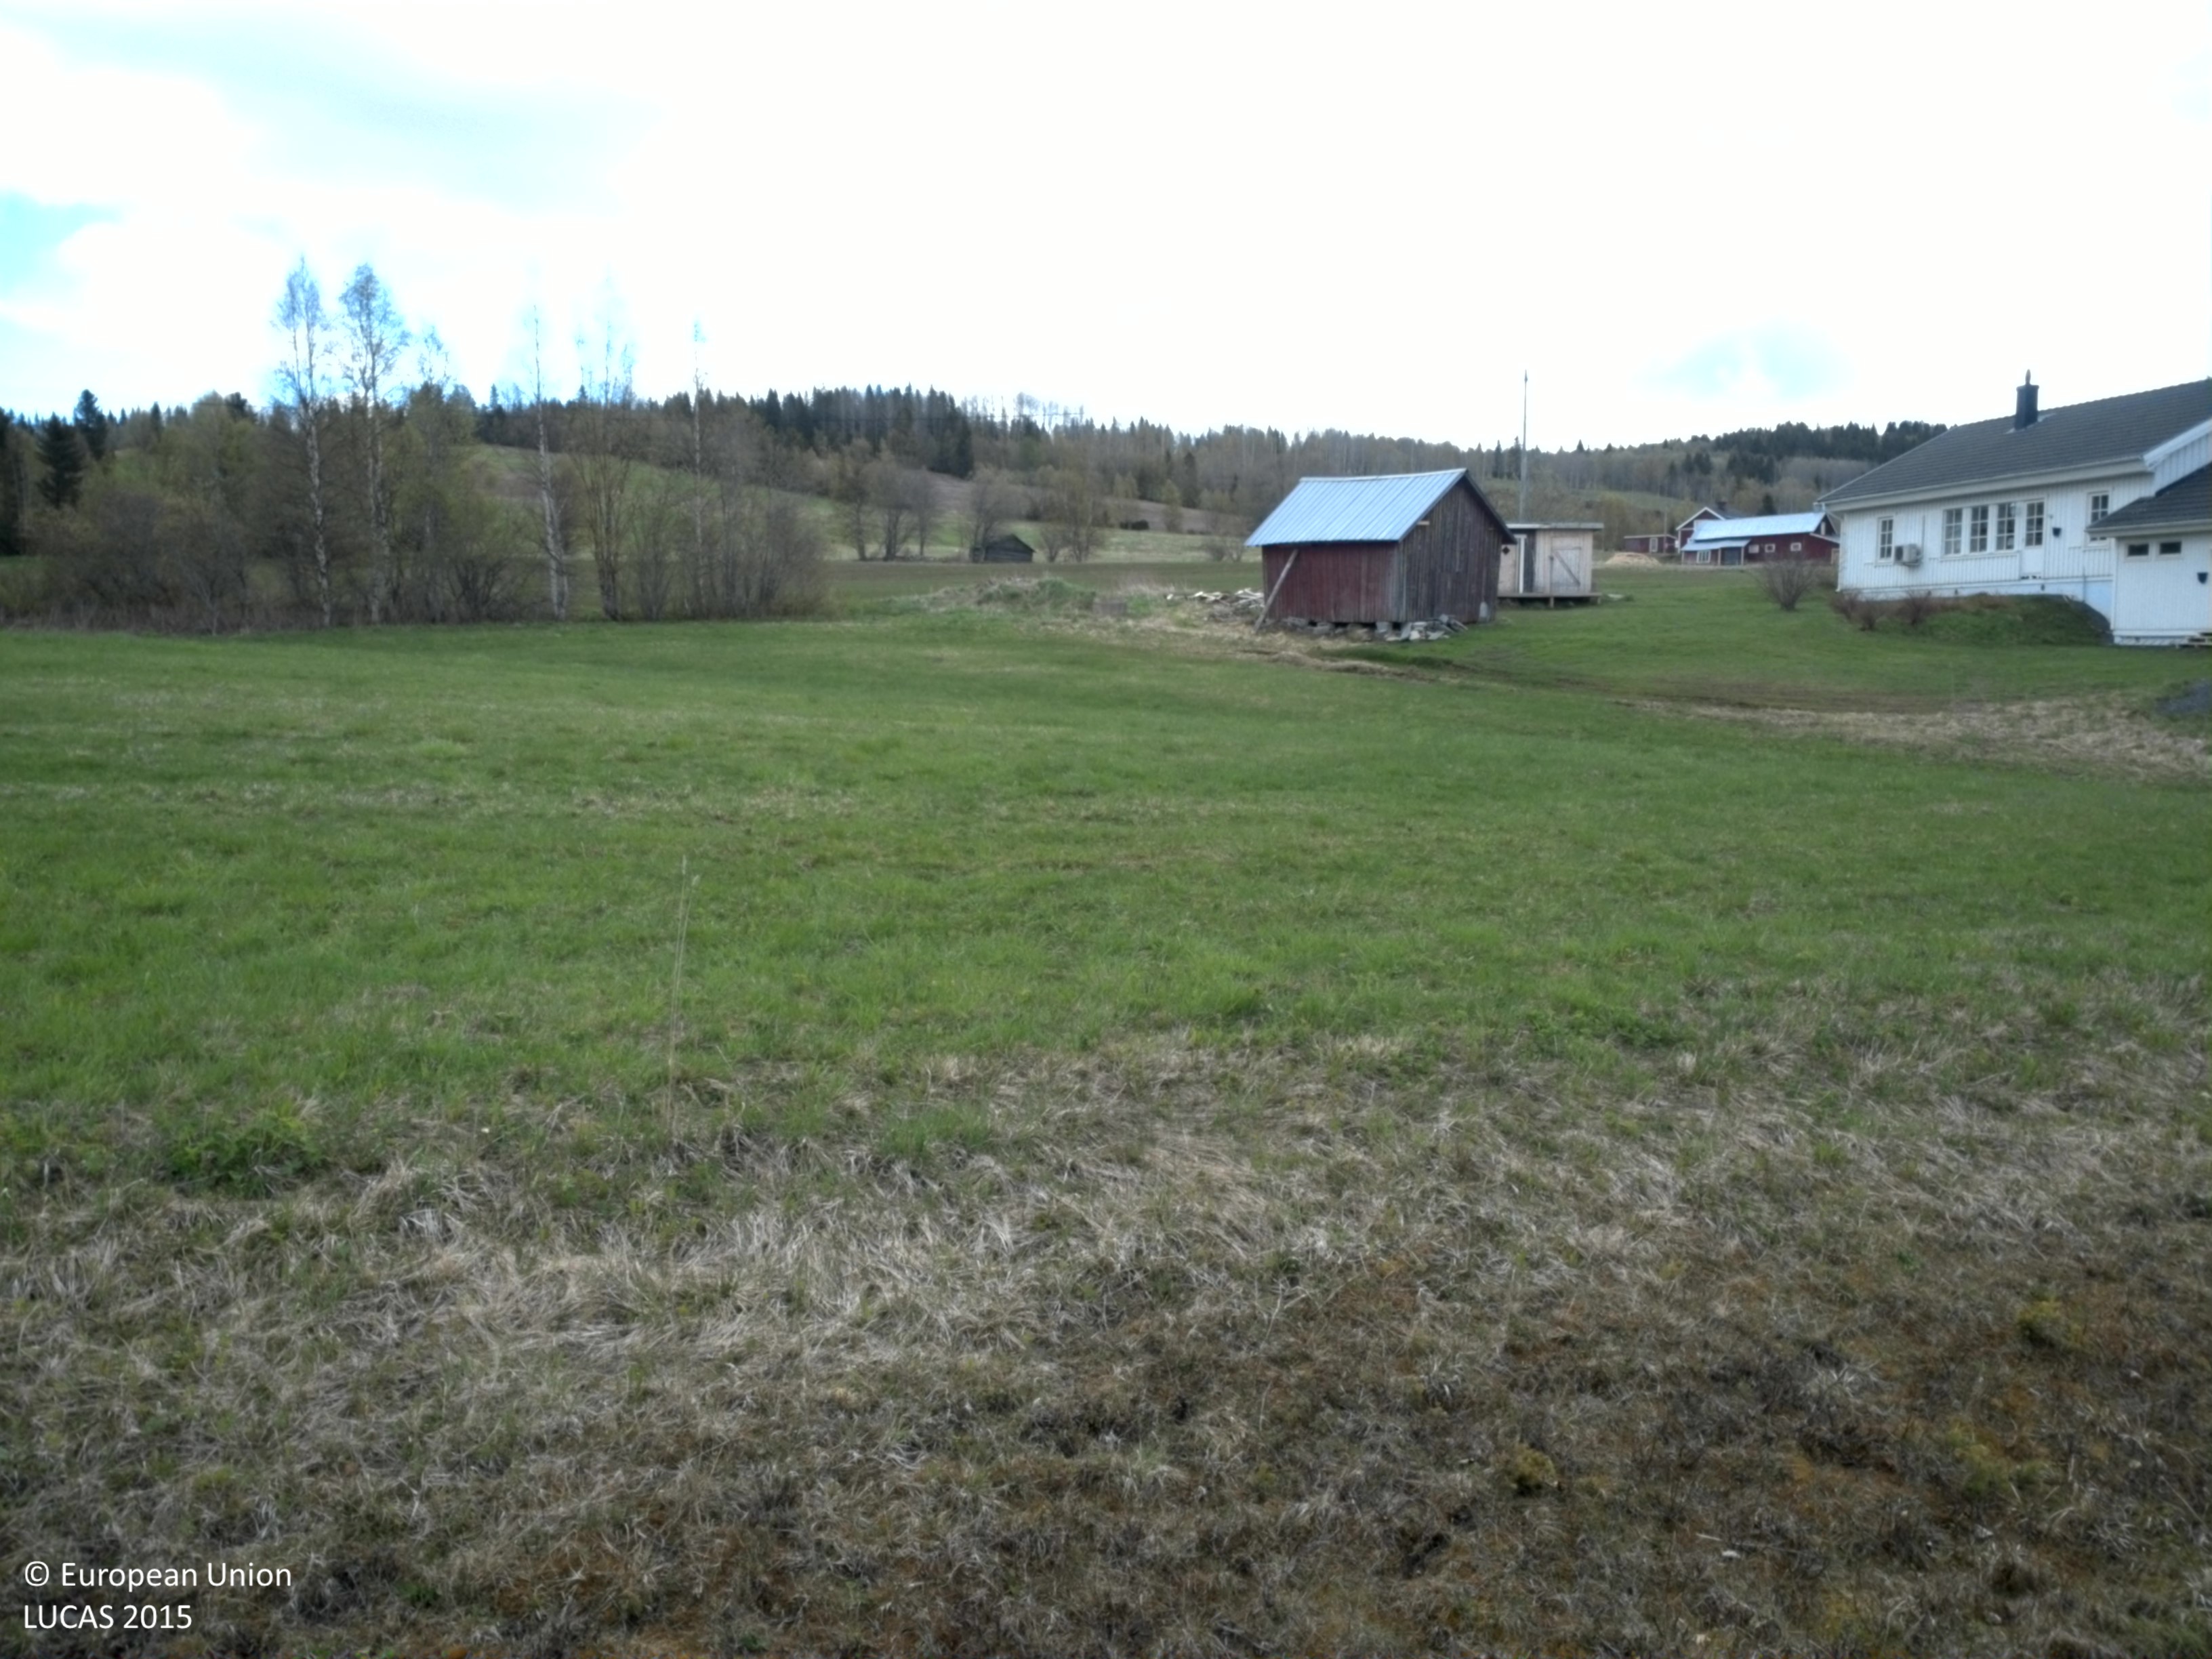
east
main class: Cropland
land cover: Other leguminous and mixtures for fodder
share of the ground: > 75 %
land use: Agriculture (excluding fallow land and kitchen gardens)
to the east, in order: Other leguminous and mixtures for fodder; Electric lines; Other leguminous and mixtures for fodder; Shruby margins; Fences; Shruby margins; Grassland without tree/shrub cover; Fences; Grassland without tree/shrub cover
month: June
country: SE
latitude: 63.5009
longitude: 13.8973
